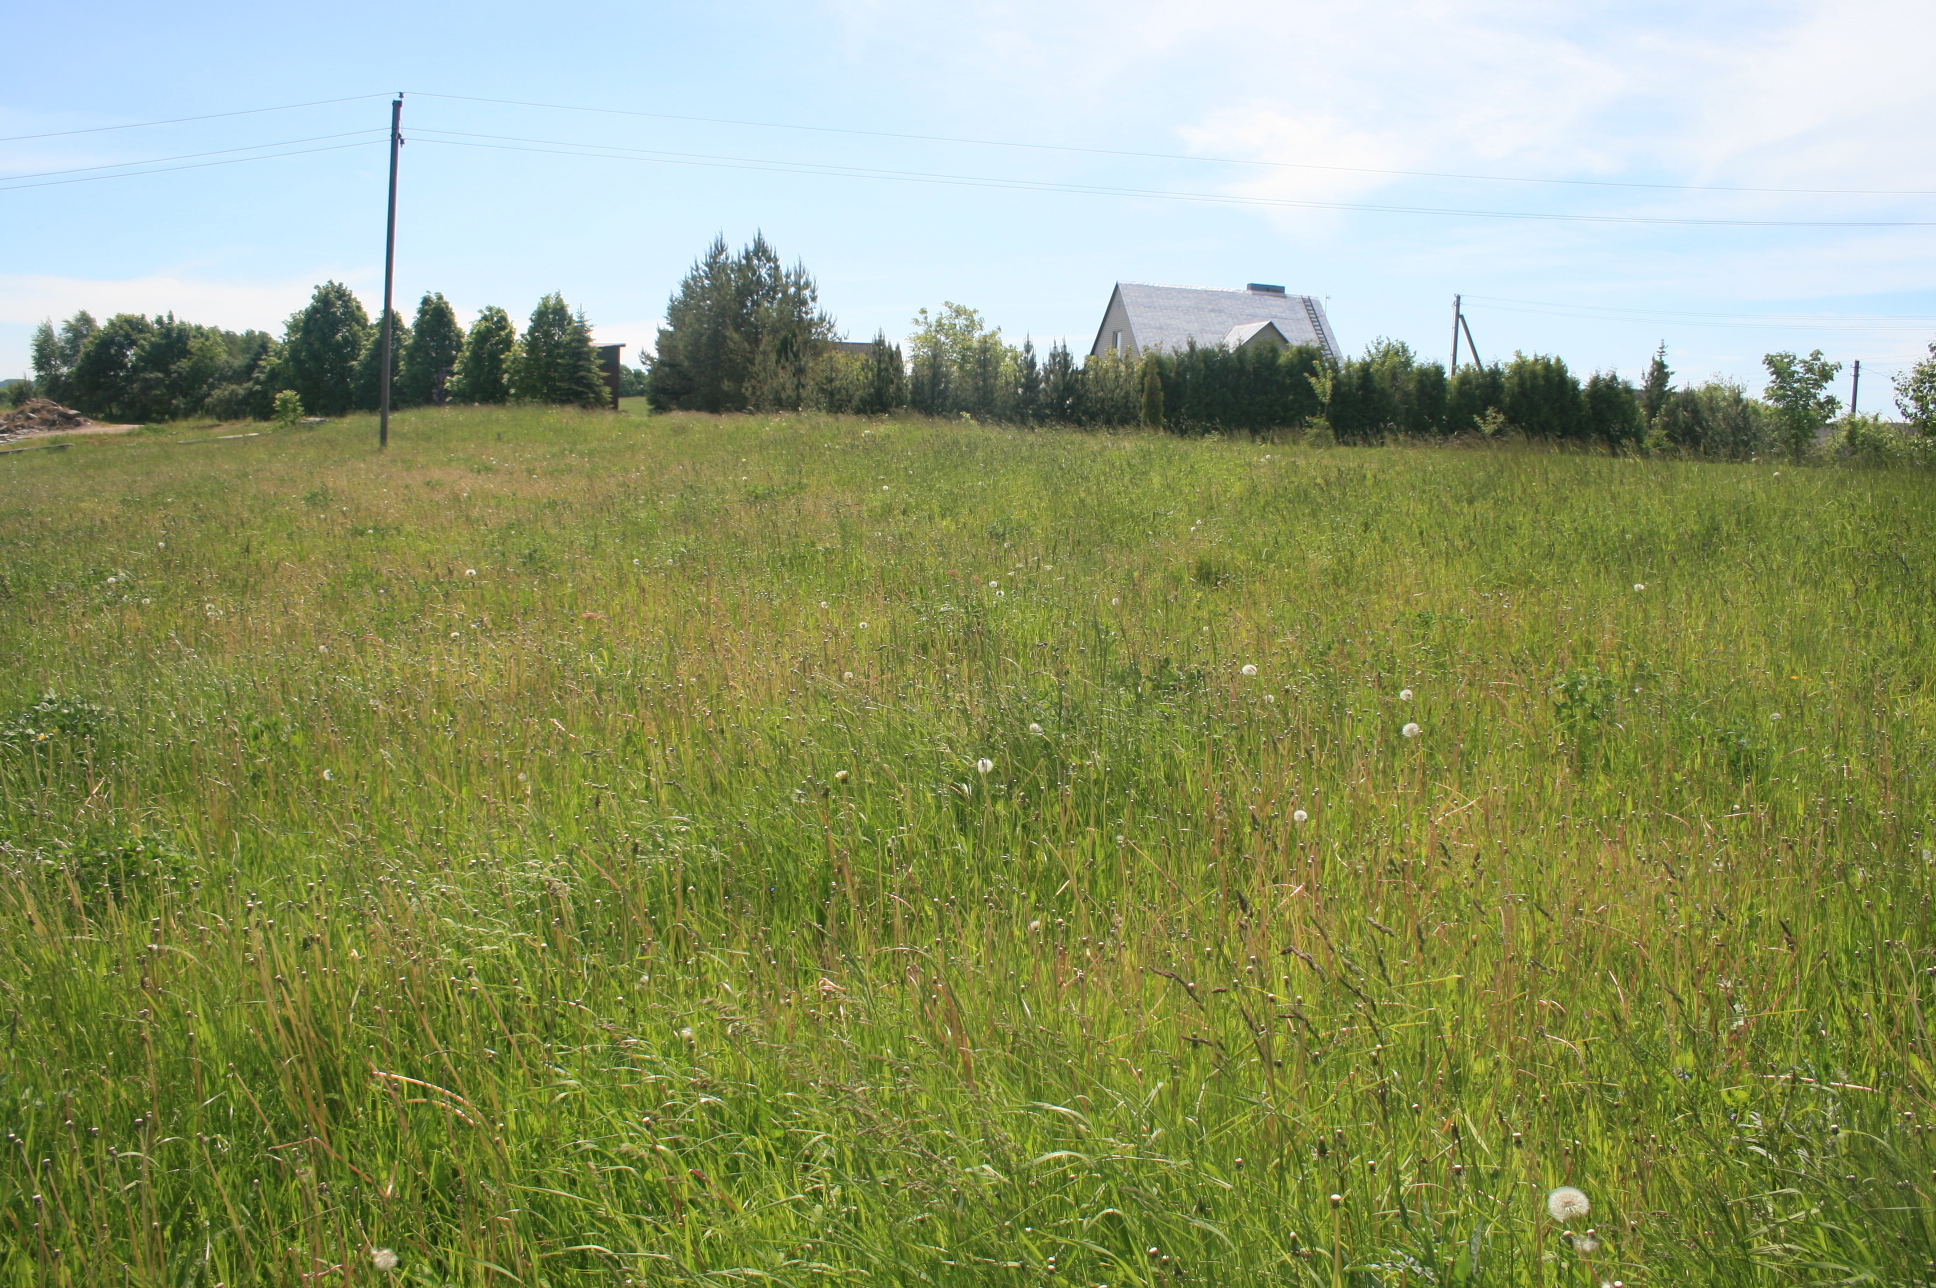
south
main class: Grassland
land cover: Grassland without tree/shrub cover
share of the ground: > 75 %
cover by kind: herbaceous plants 100 %
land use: Agriculture (excluding fallow land and kitchen gardens)
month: June
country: LT
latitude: 55.9358
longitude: 22.3351
